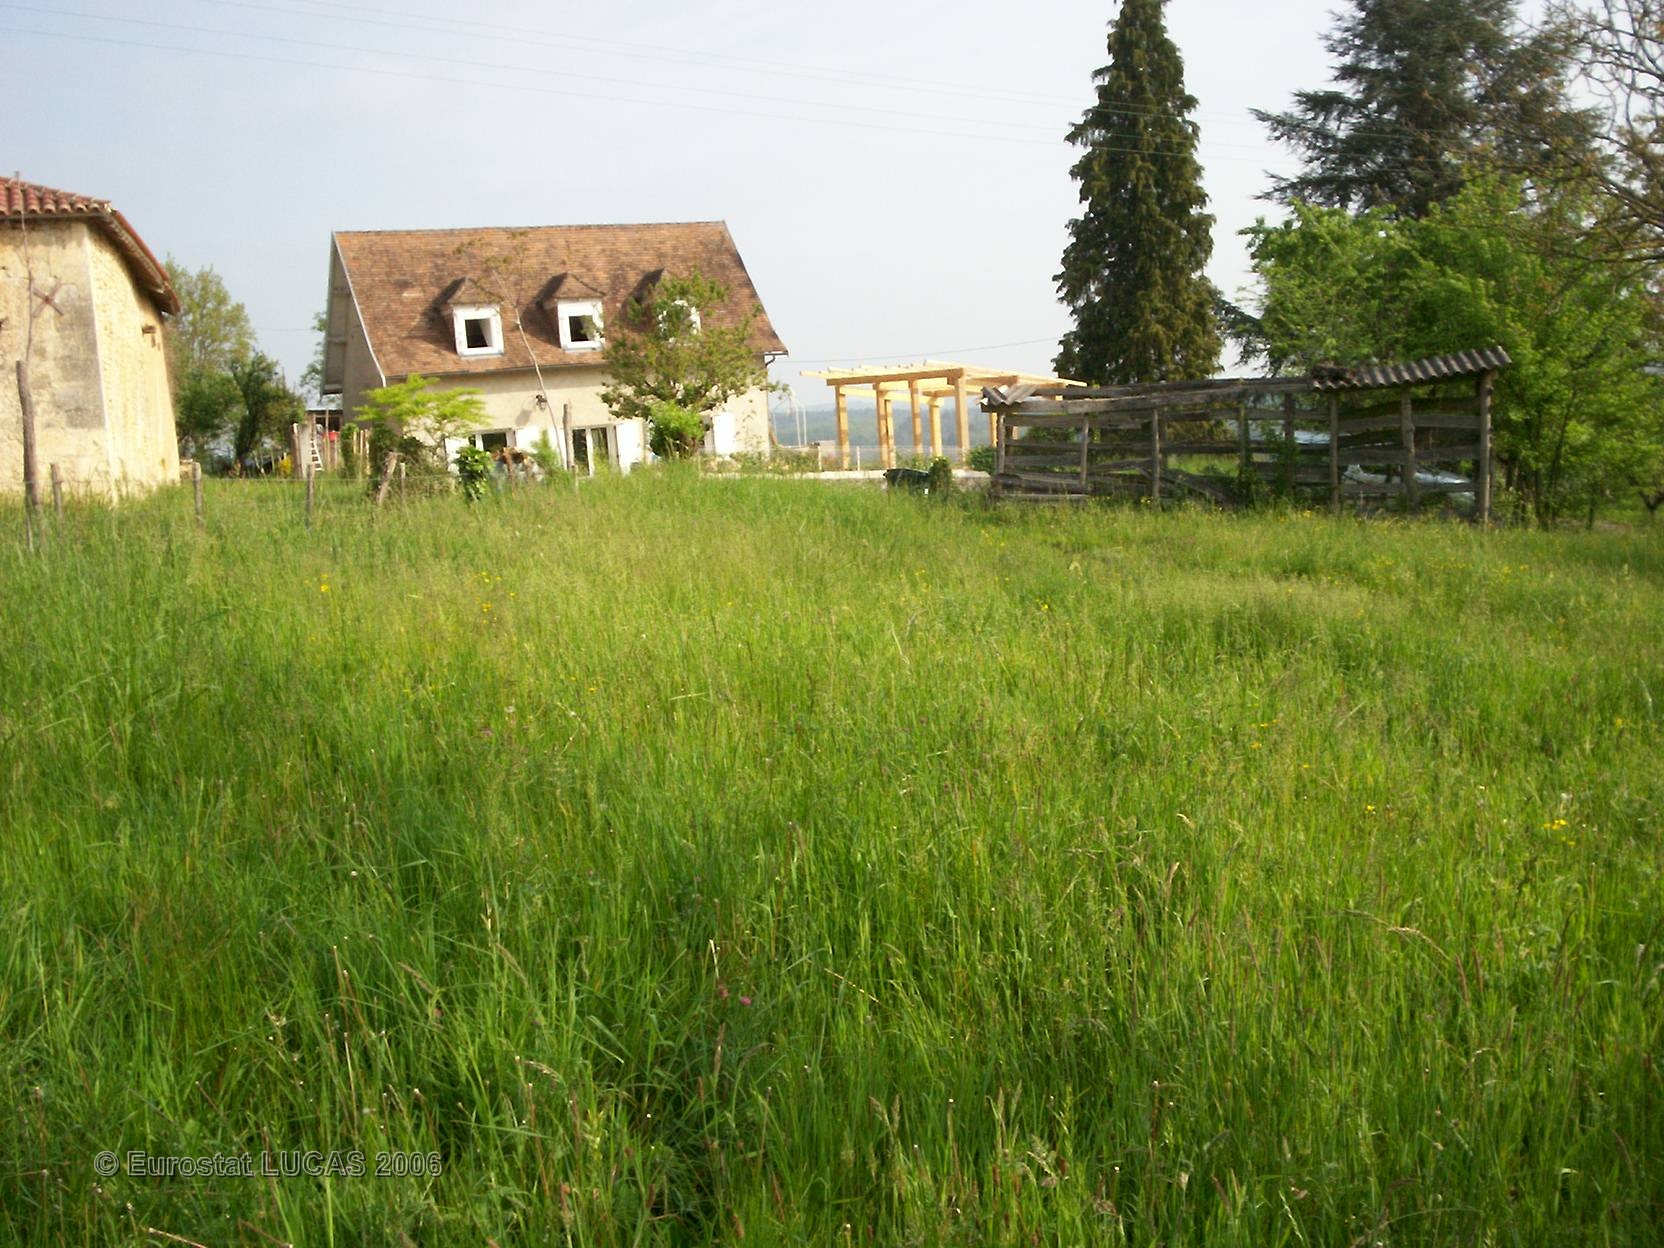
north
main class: Grassland
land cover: Grassland with sparse tree/shrub cover
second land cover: Nuts trees
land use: Agriculture (excluding fallow land and kitchen gardens)
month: May
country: FR
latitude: 45.2317
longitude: 0.8326
